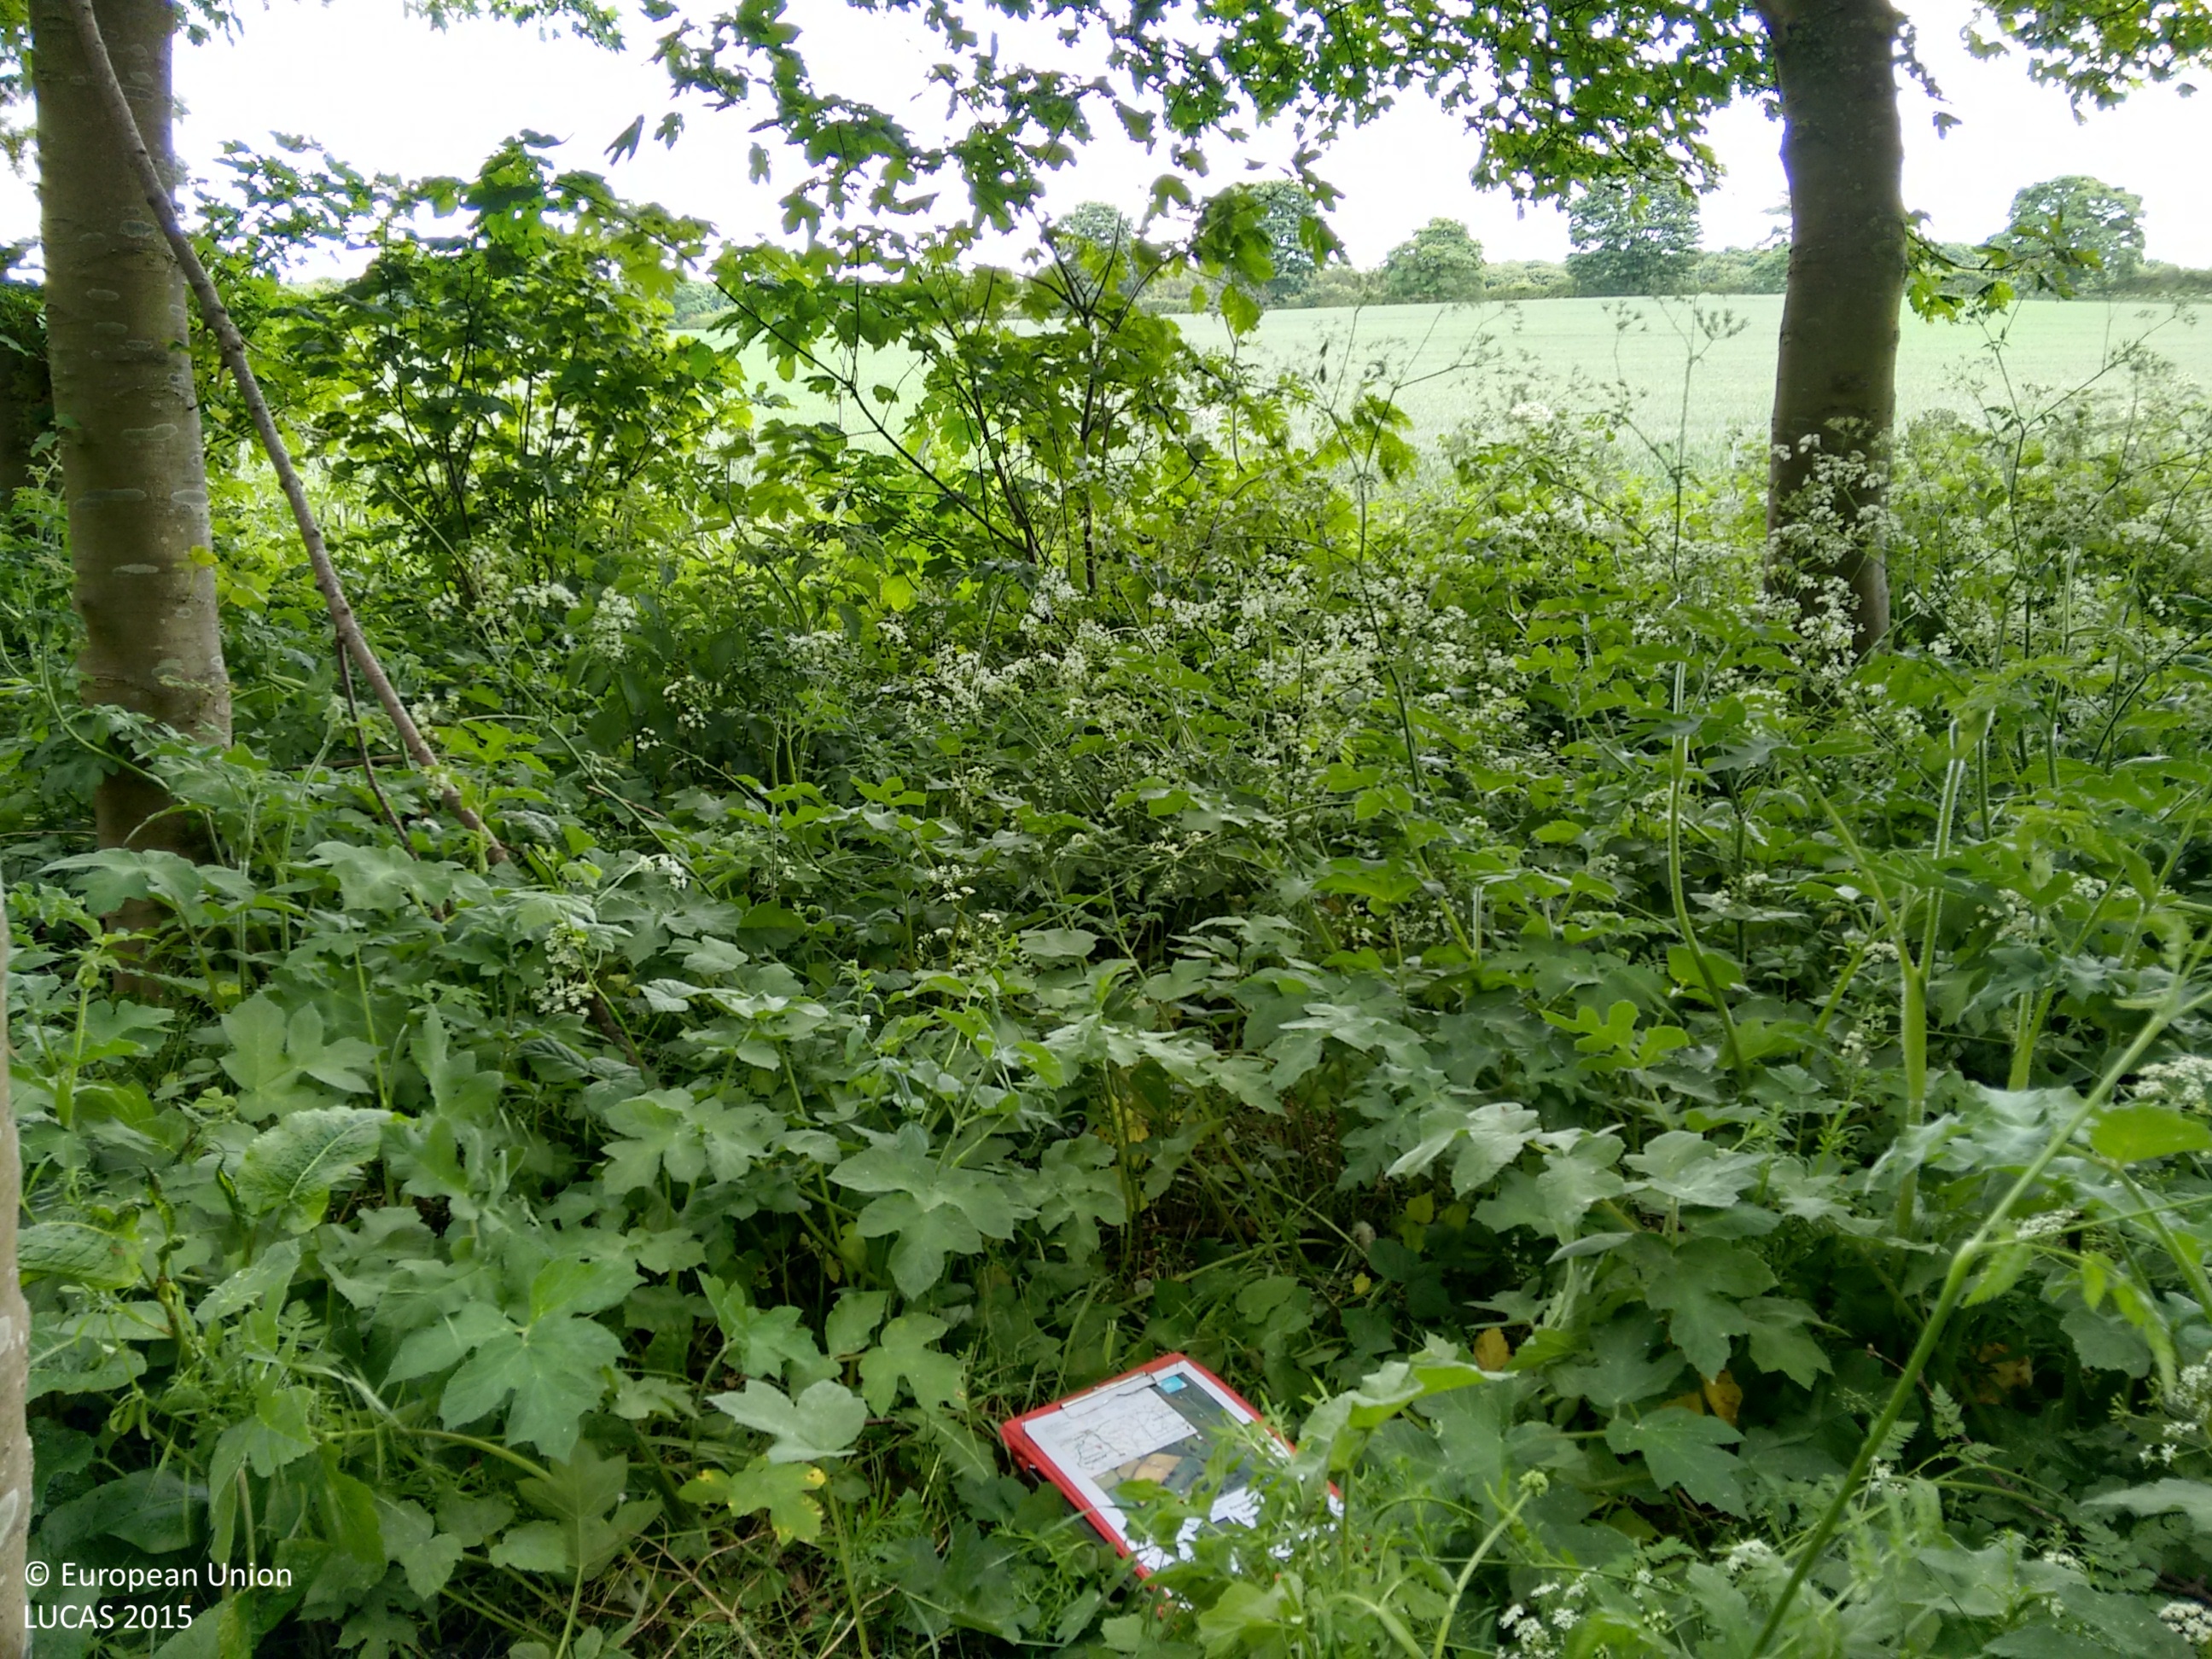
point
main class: Woodland
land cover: Broadleaved woodland
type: mesophytic deciduous forest
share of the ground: > 75 %
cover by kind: broadleaved forest trees 100 %
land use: Agriculture (excluding fallow land and kitchen gardens)
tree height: > 5 m
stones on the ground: < 10 %
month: June
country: GB
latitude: 52.8017
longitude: -0.6750
